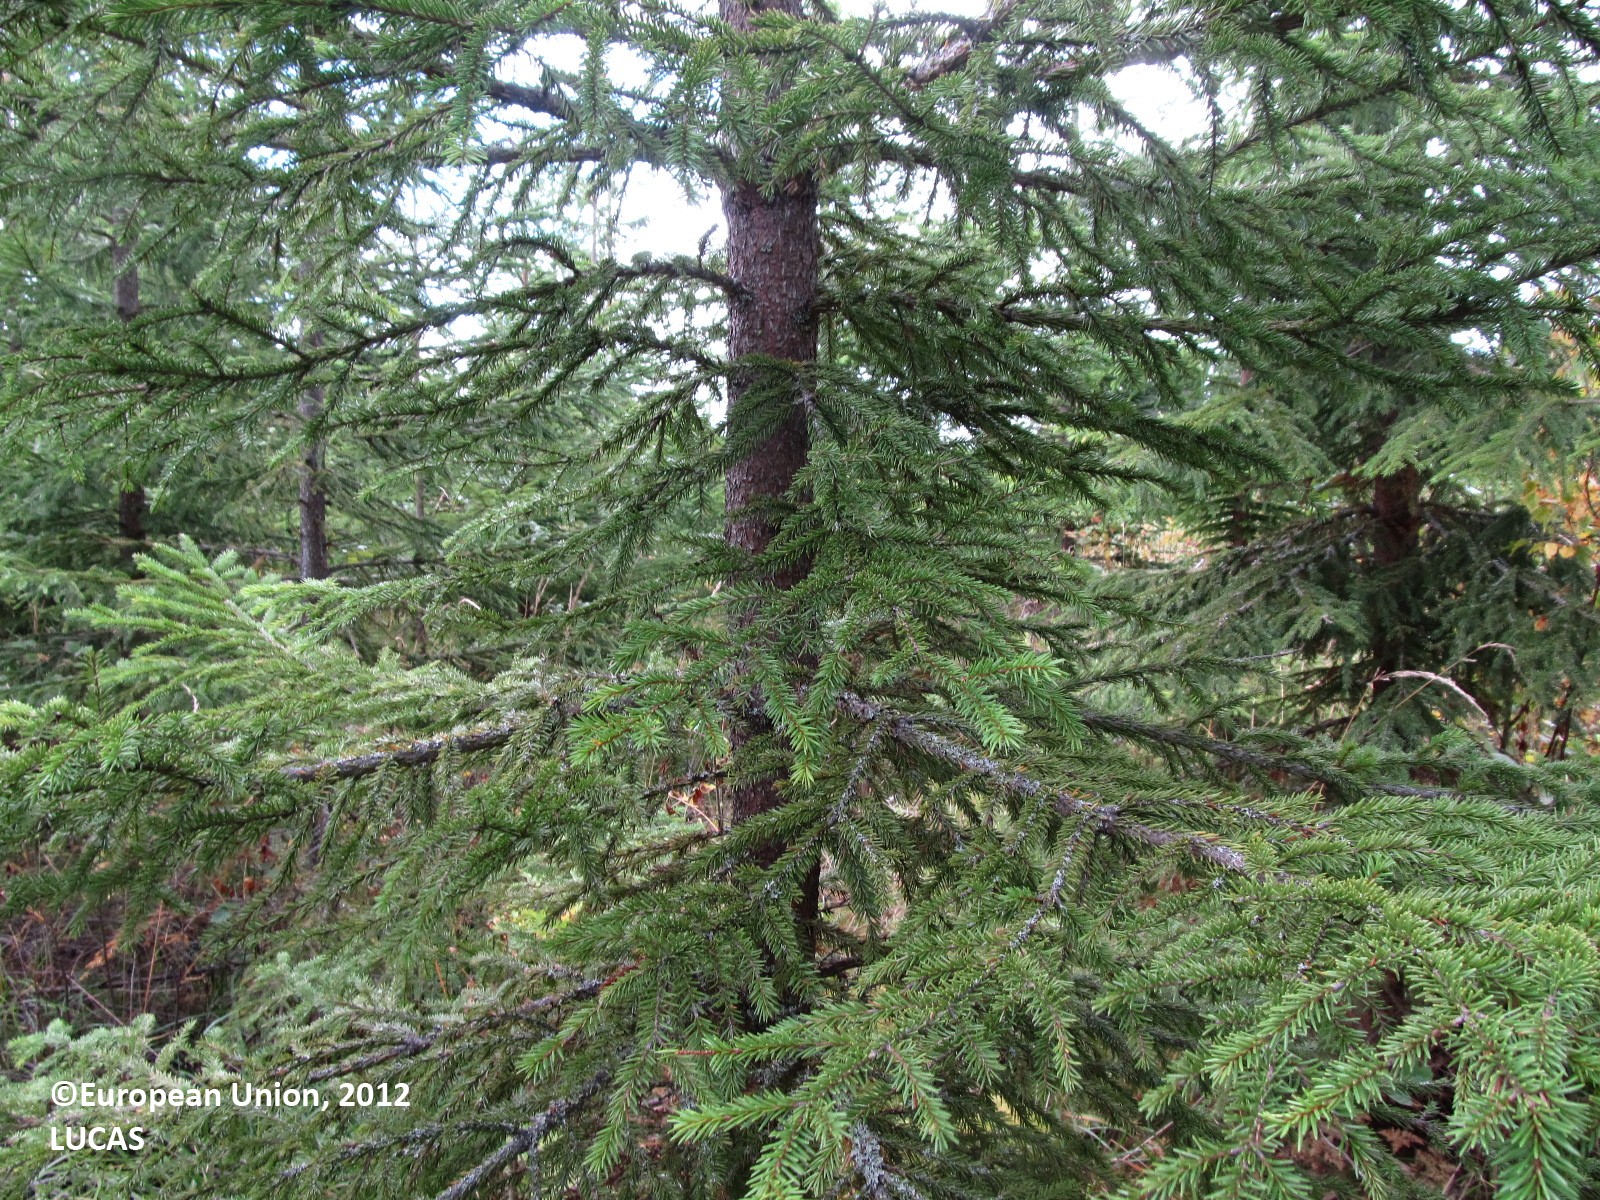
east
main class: Woodland
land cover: Spruce dominated coniferous woodland
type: boreal forest
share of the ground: 50 - 75 %
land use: Forestry
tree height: > 5 m
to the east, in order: Spruce dominated coniferous woodland; Broadleaved woodland; Spruce dominated coniferous woodland
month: September
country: FI
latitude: 62.6787
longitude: 28.4982
